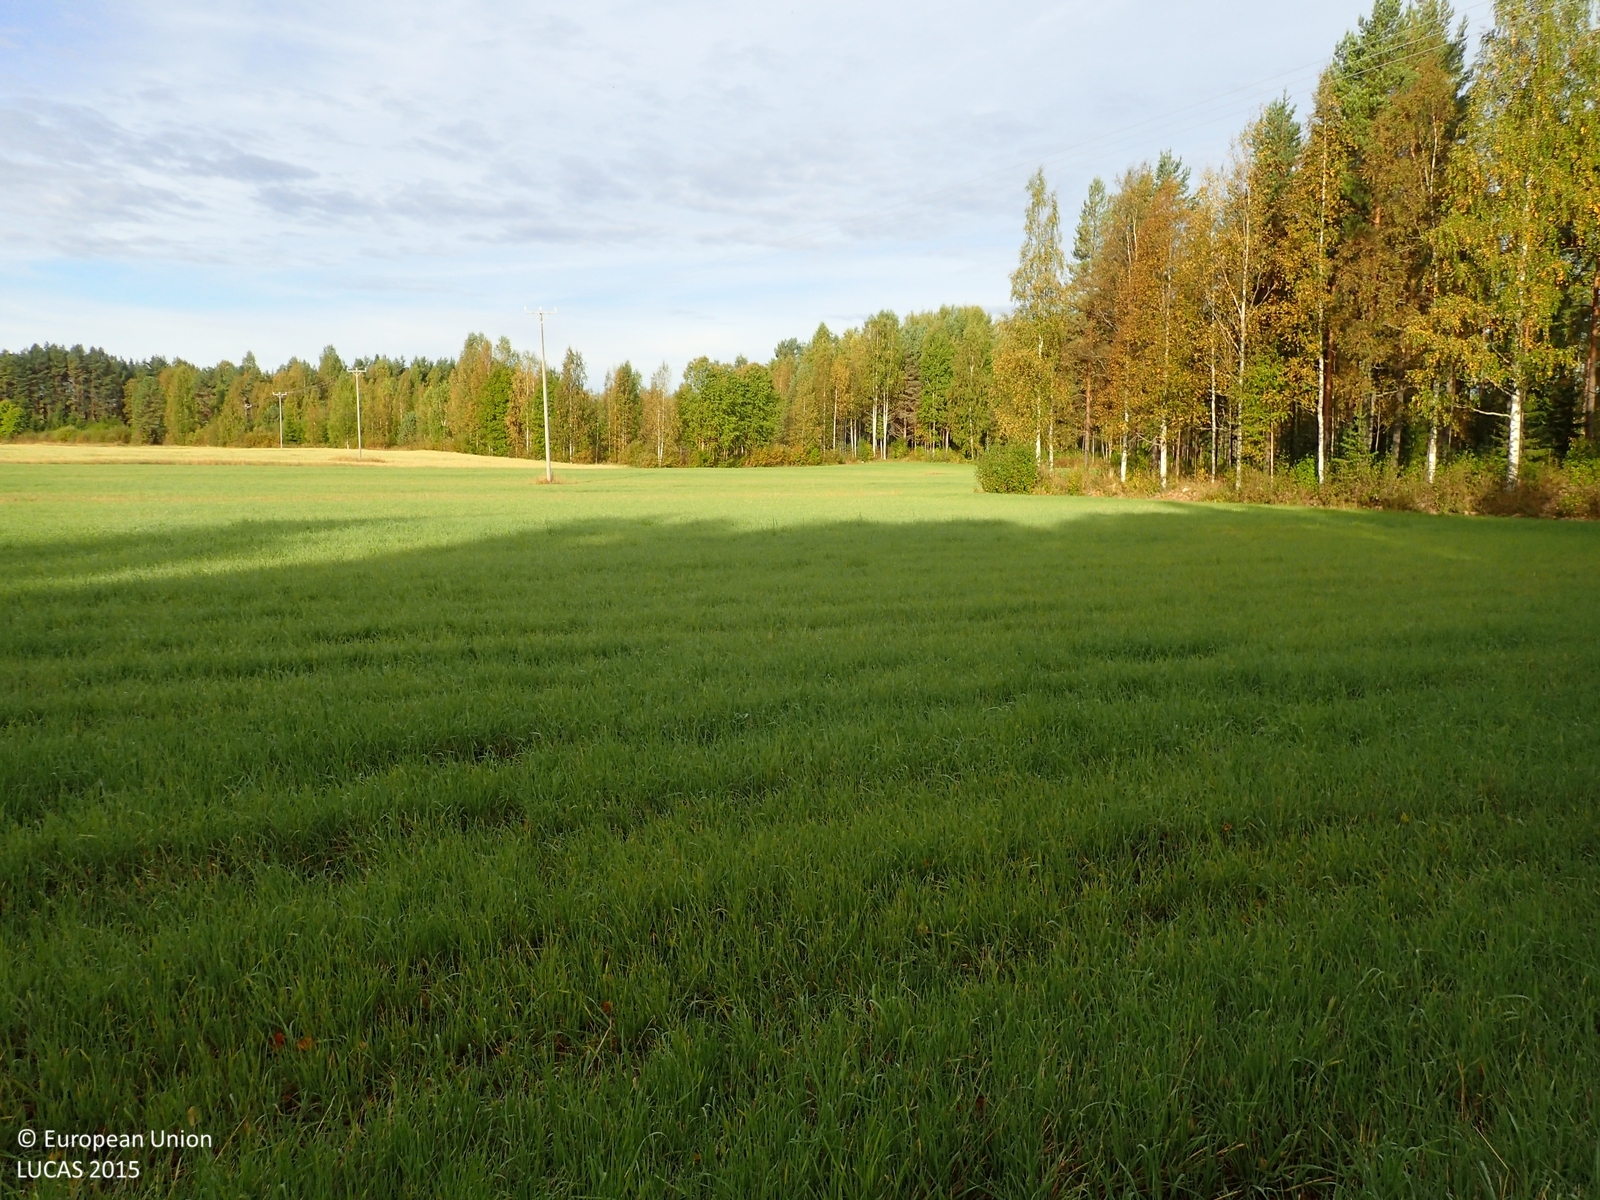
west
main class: Cropland
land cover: Temporary grasslands
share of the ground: > 75 %
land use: Agriculture (excluding fallow land and kitchen gardens)
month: September
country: FI
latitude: 63.1203
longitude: 25.9570
